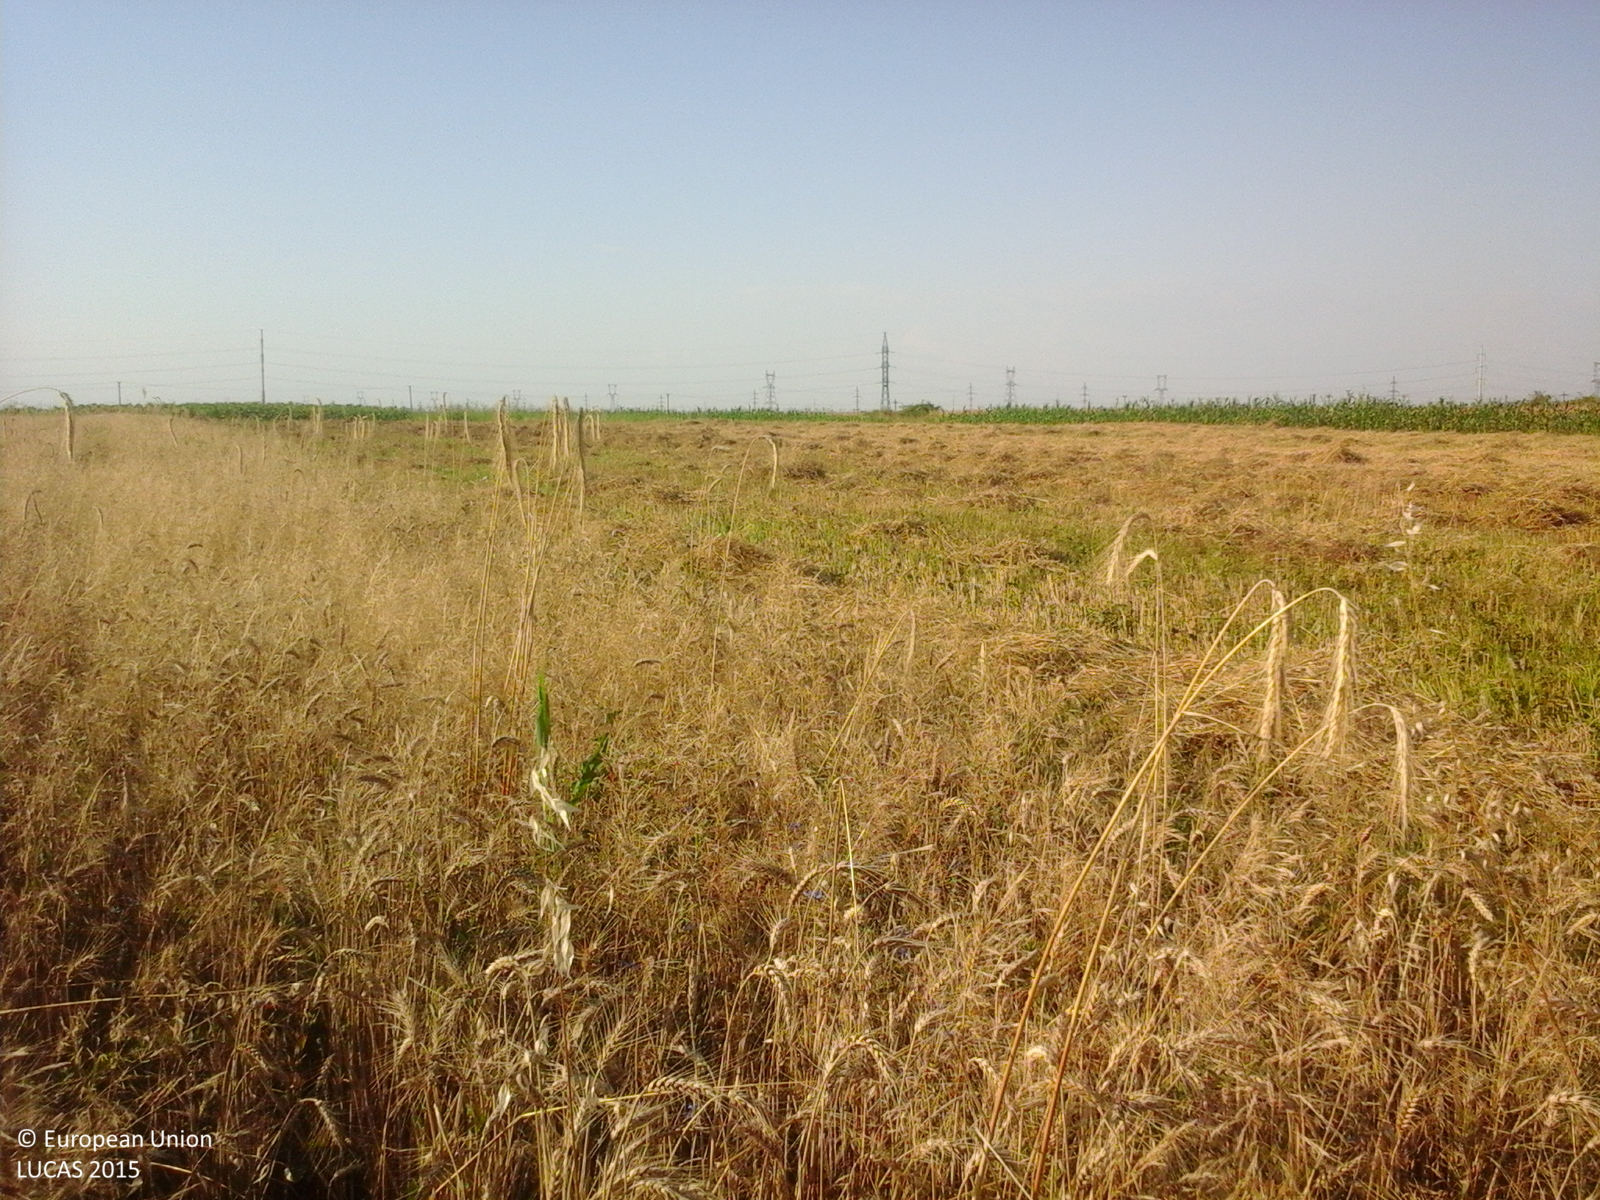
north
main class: Cropland
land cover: Common wheat
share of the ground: > 75 %
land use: Agriculture (excluding fallow land and kitchen gardens)
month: July
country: RO
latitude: 44.2469
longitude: 24.4568
